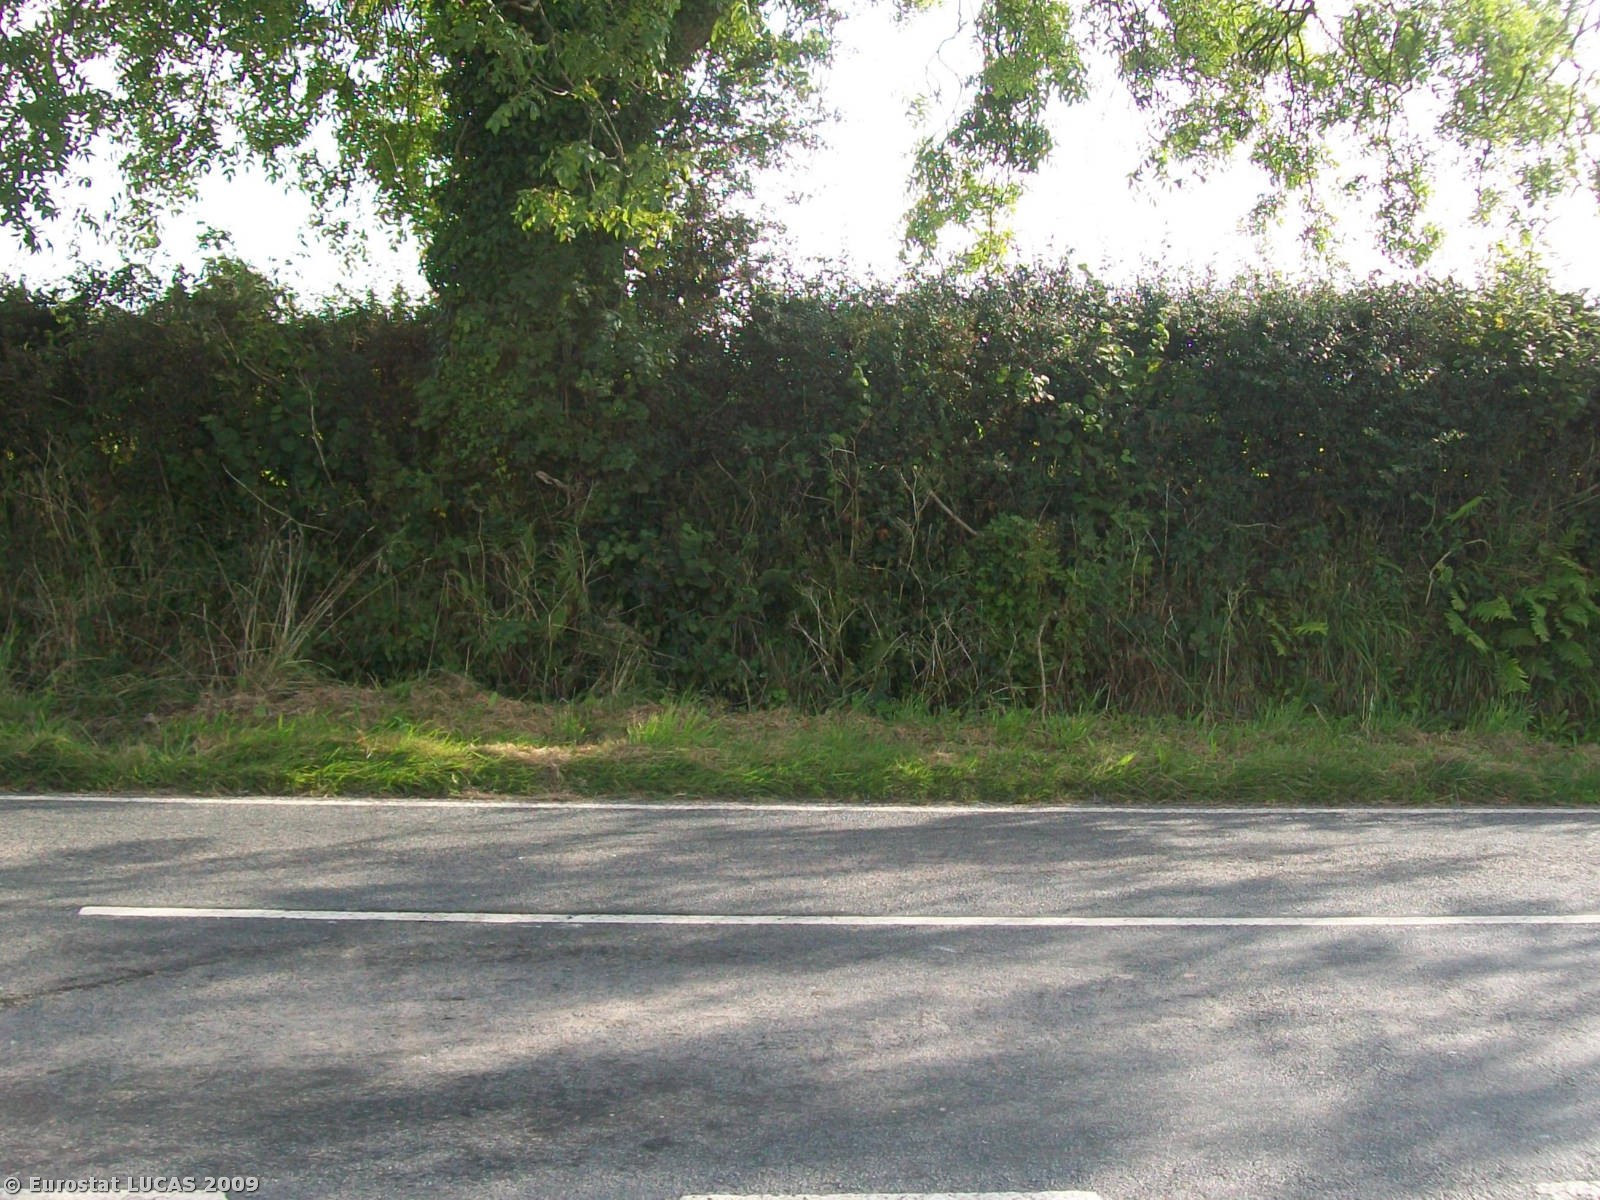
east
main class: Grassland
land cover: Grassland without tree/shrub cover
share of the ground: > 75 %
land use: Agriculture (excluding fallow land and kitchen gardens)
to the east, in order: Grassland without tree/shrub cover; Managed hedges; Grass margins; Paved roads, cycling and walking lanes; Grass margins; Managed hedges; Grassland without tree/shrub cover
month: September
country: GB
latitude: 51.7836
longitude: -4.7076
